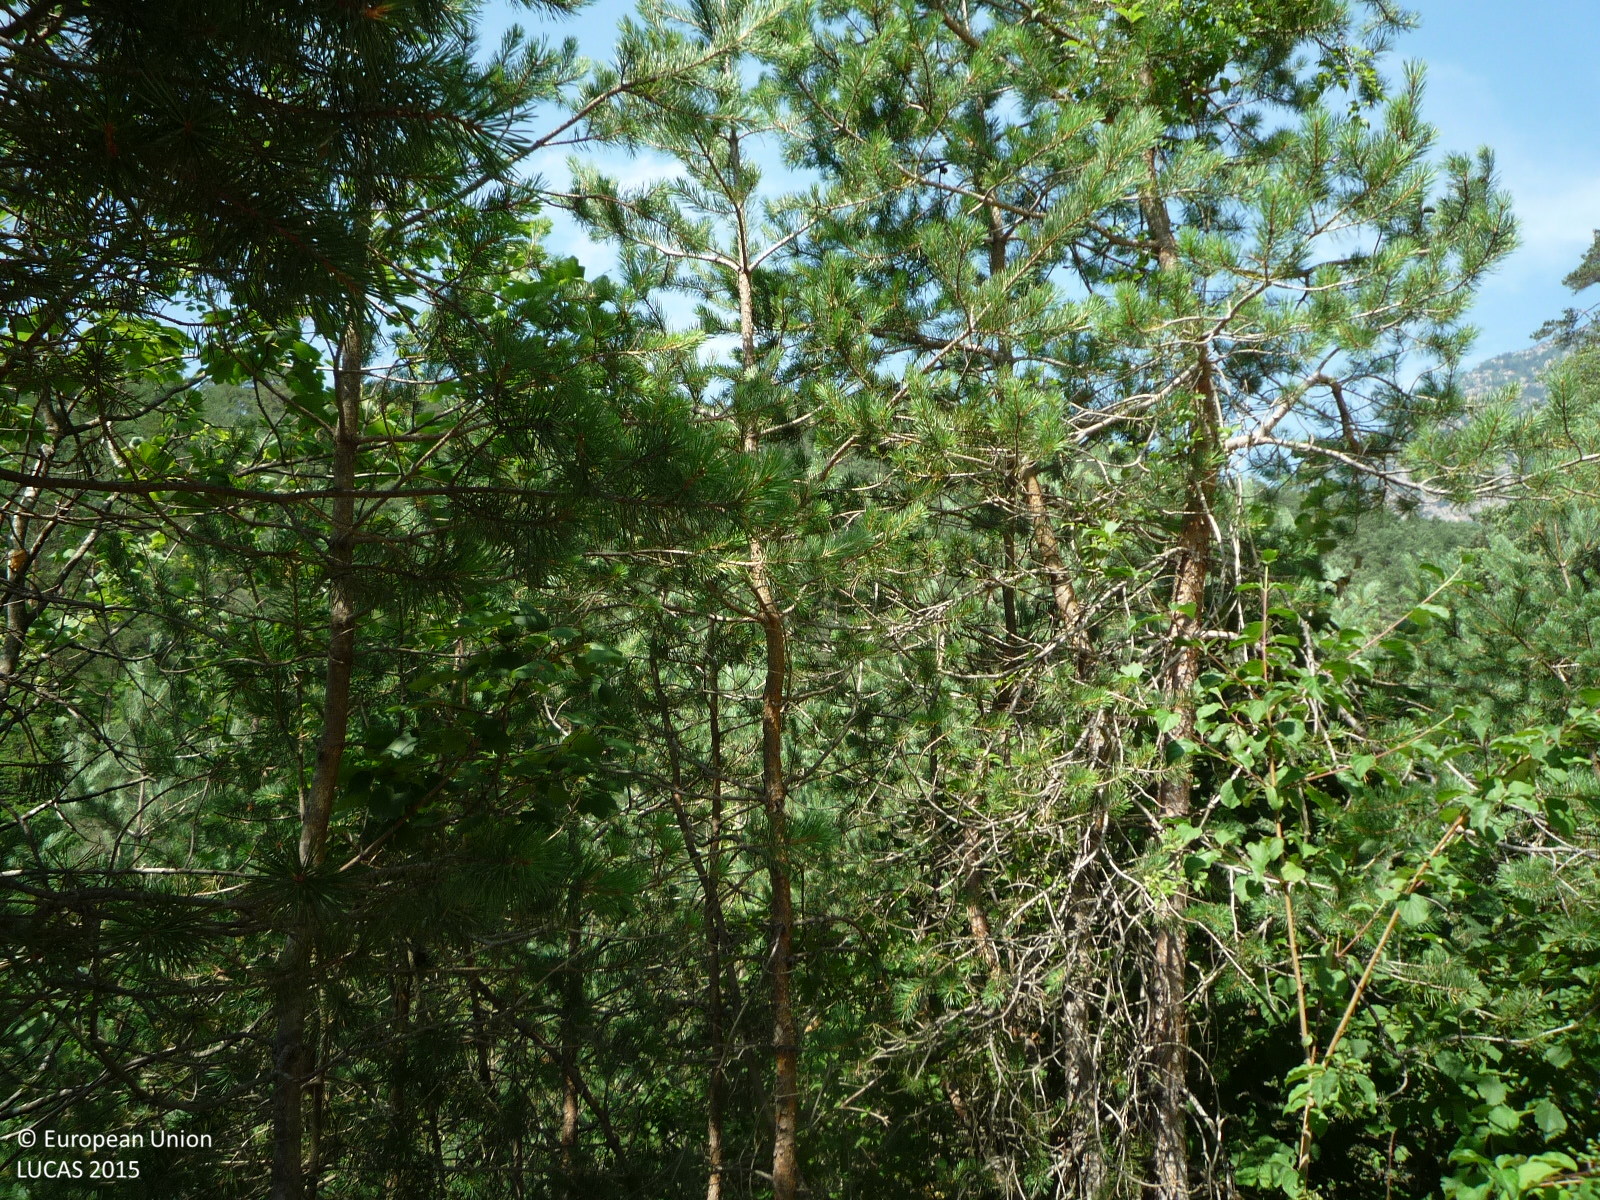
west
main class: Woodland
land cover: Pine dominated mixed woodland
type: coniferous forest of the mediterranean region
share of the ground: > 75 %
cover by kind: coniferous forest trees 55 %, broadleaved forest trees 45 %
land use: Semi-natural and natural areas not in use
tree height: > 5 m
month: July
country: ES
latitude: 42.1710
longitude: 1.9628
